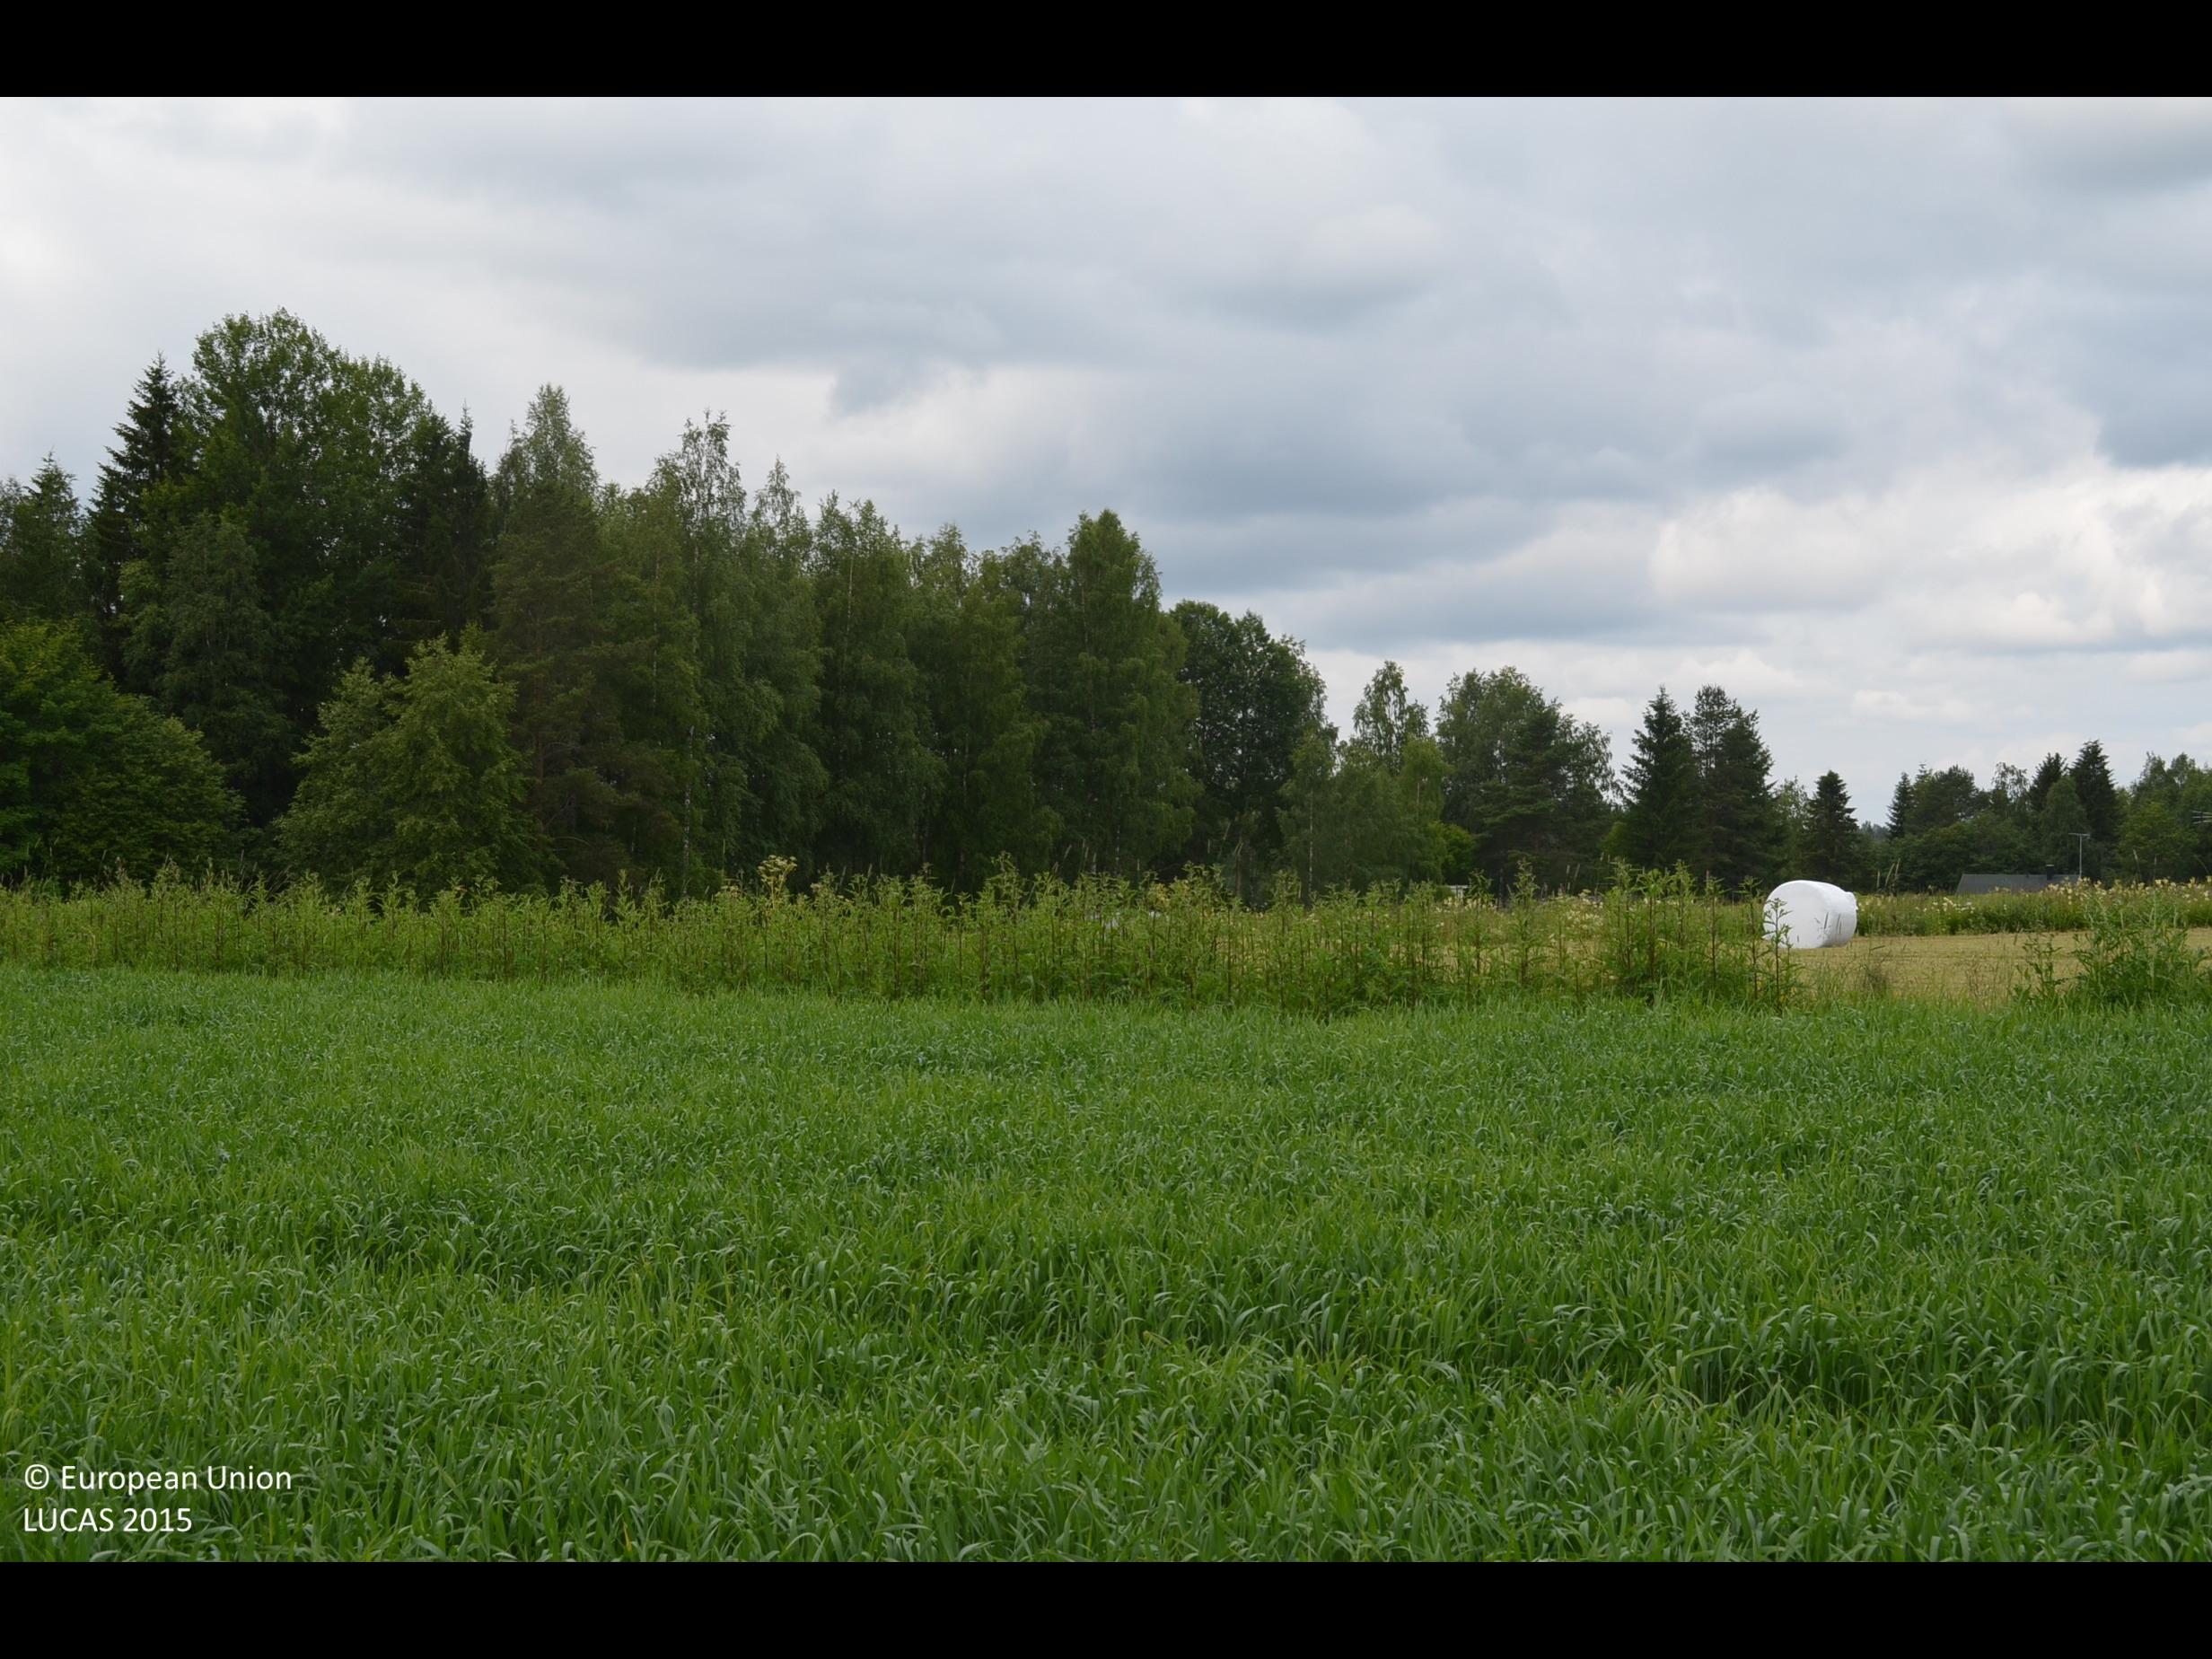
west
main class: Cropland
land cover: Common wheat
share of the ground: > 75 %
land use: Agriculture (excluding fallow land and kitchen gardens)
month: July
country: FI
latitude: 62.1560
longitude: 23.6062
